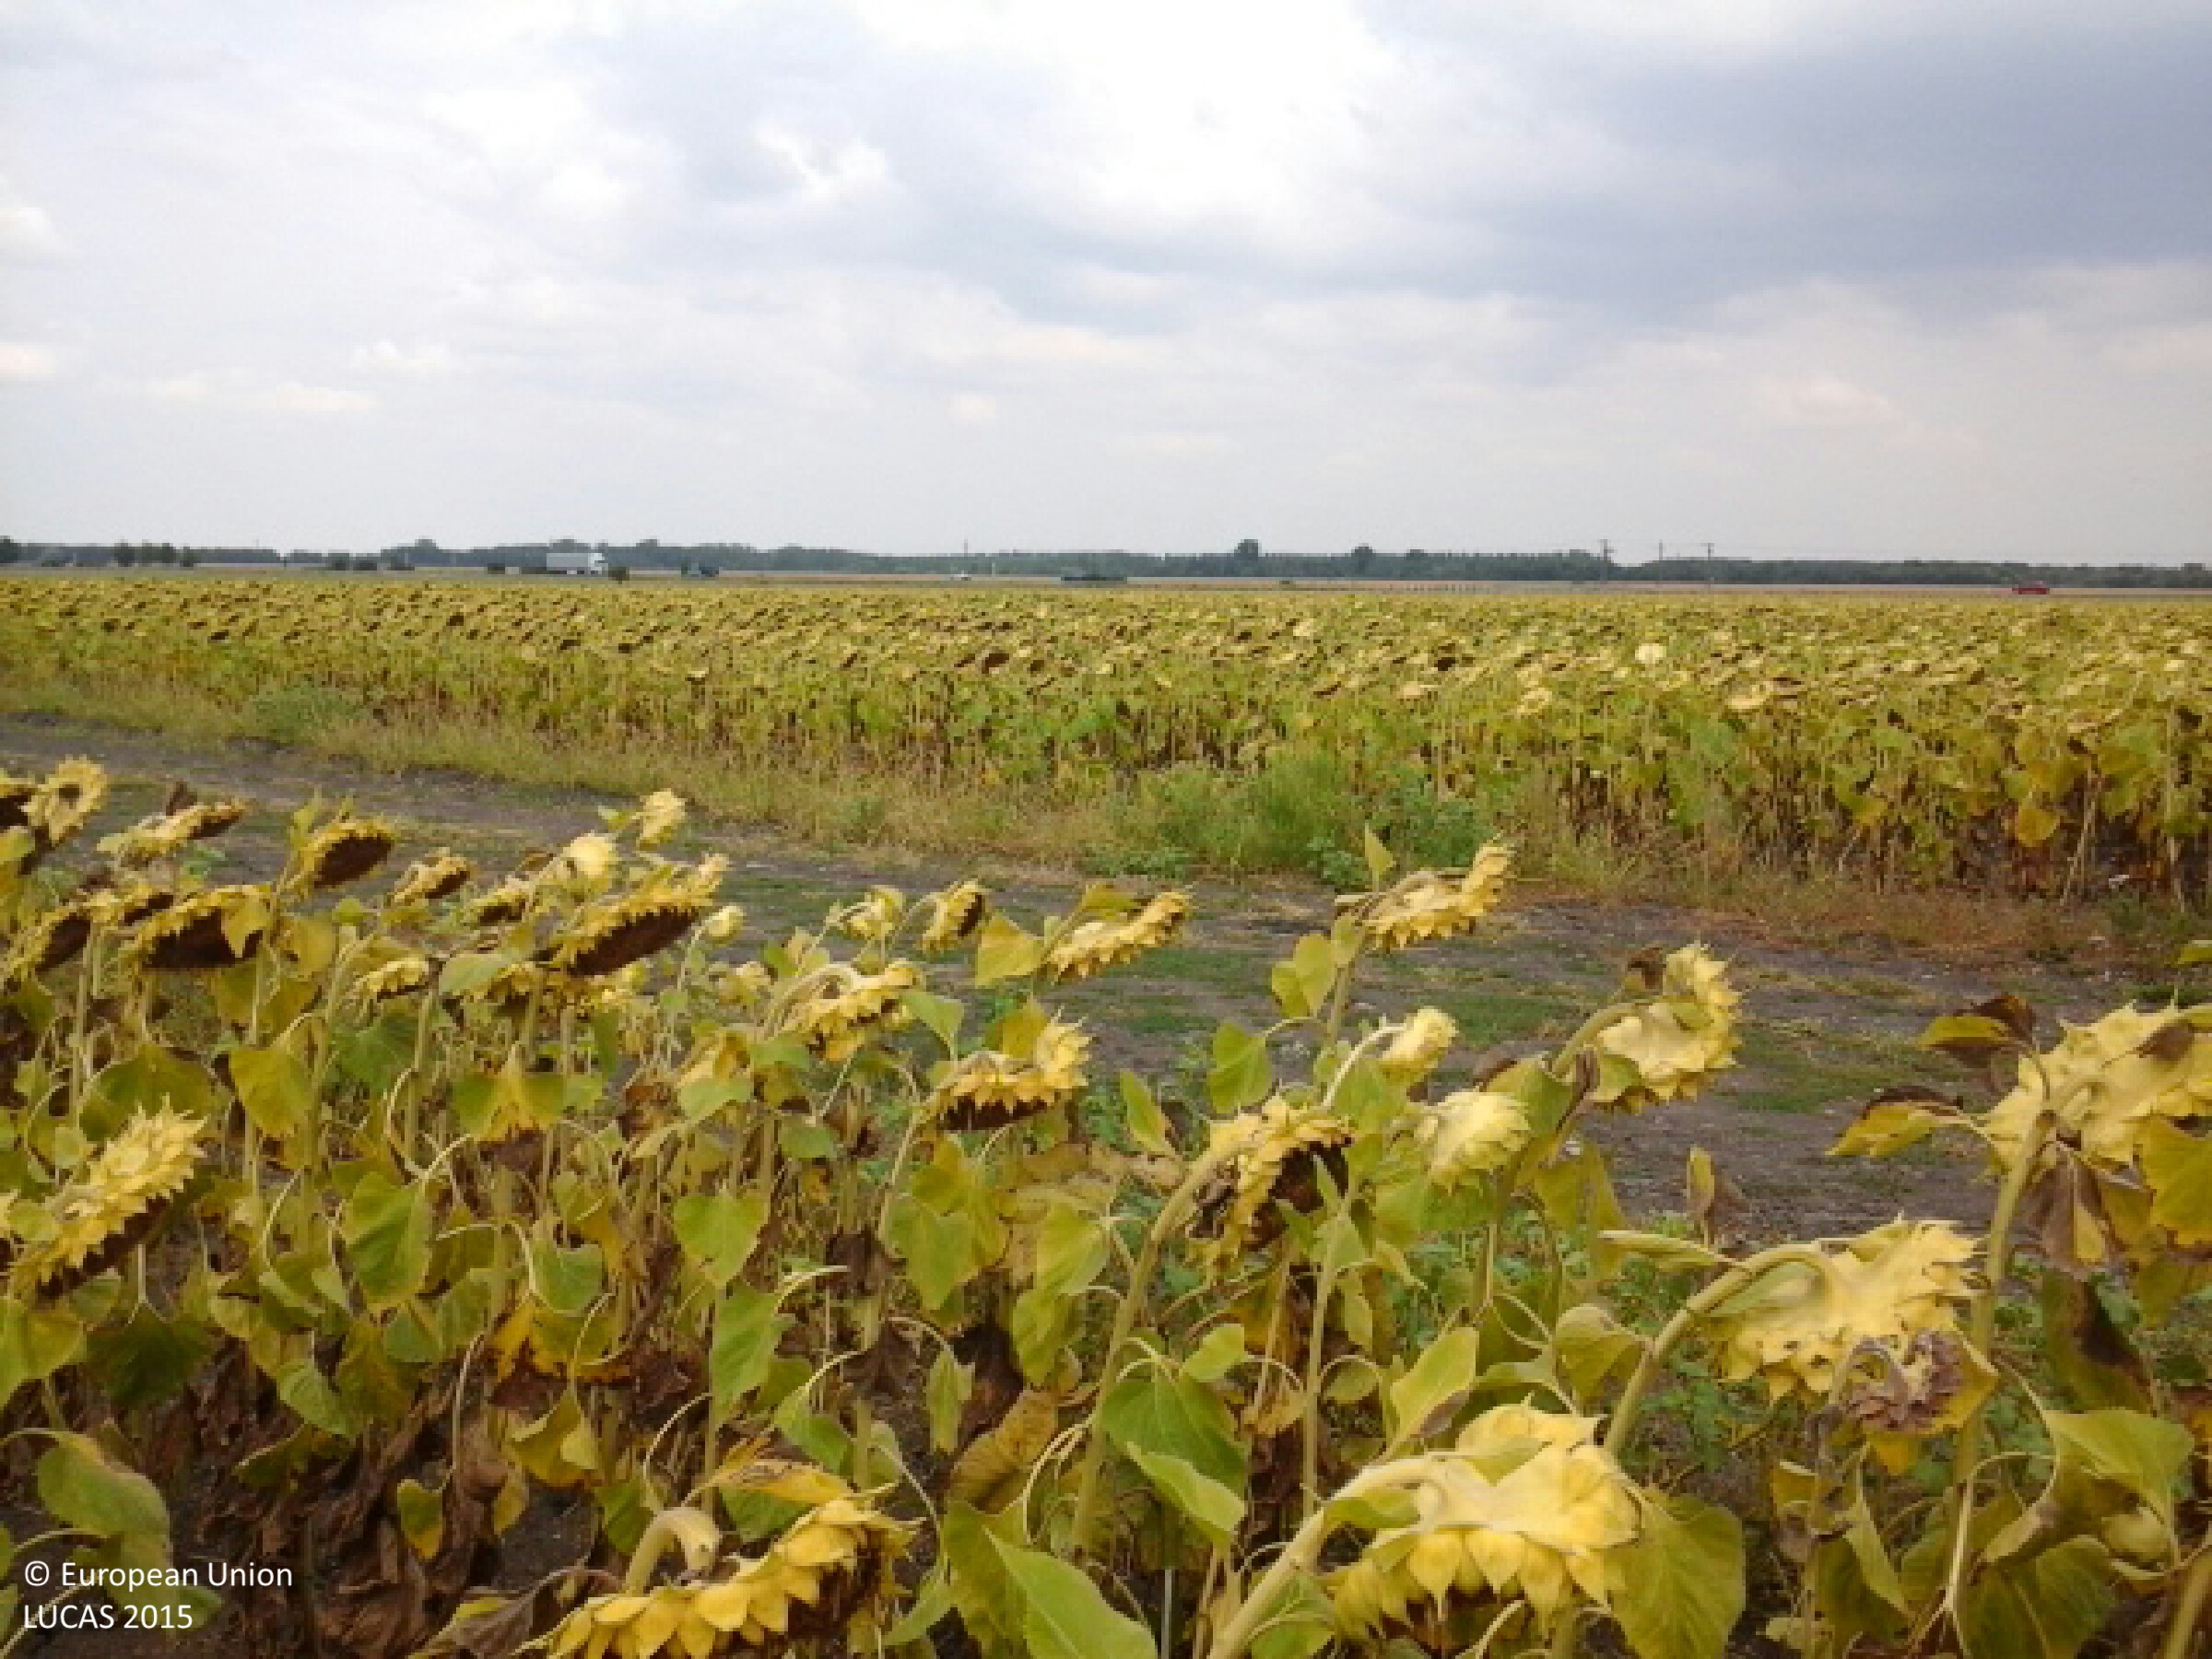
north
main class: Cropland
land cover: Sunflower
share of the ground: > 75 %
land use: Agriculture (excluding fallow land and kitchen gardens)
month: August
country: HU
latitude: 47.1477
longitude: 21.6613
